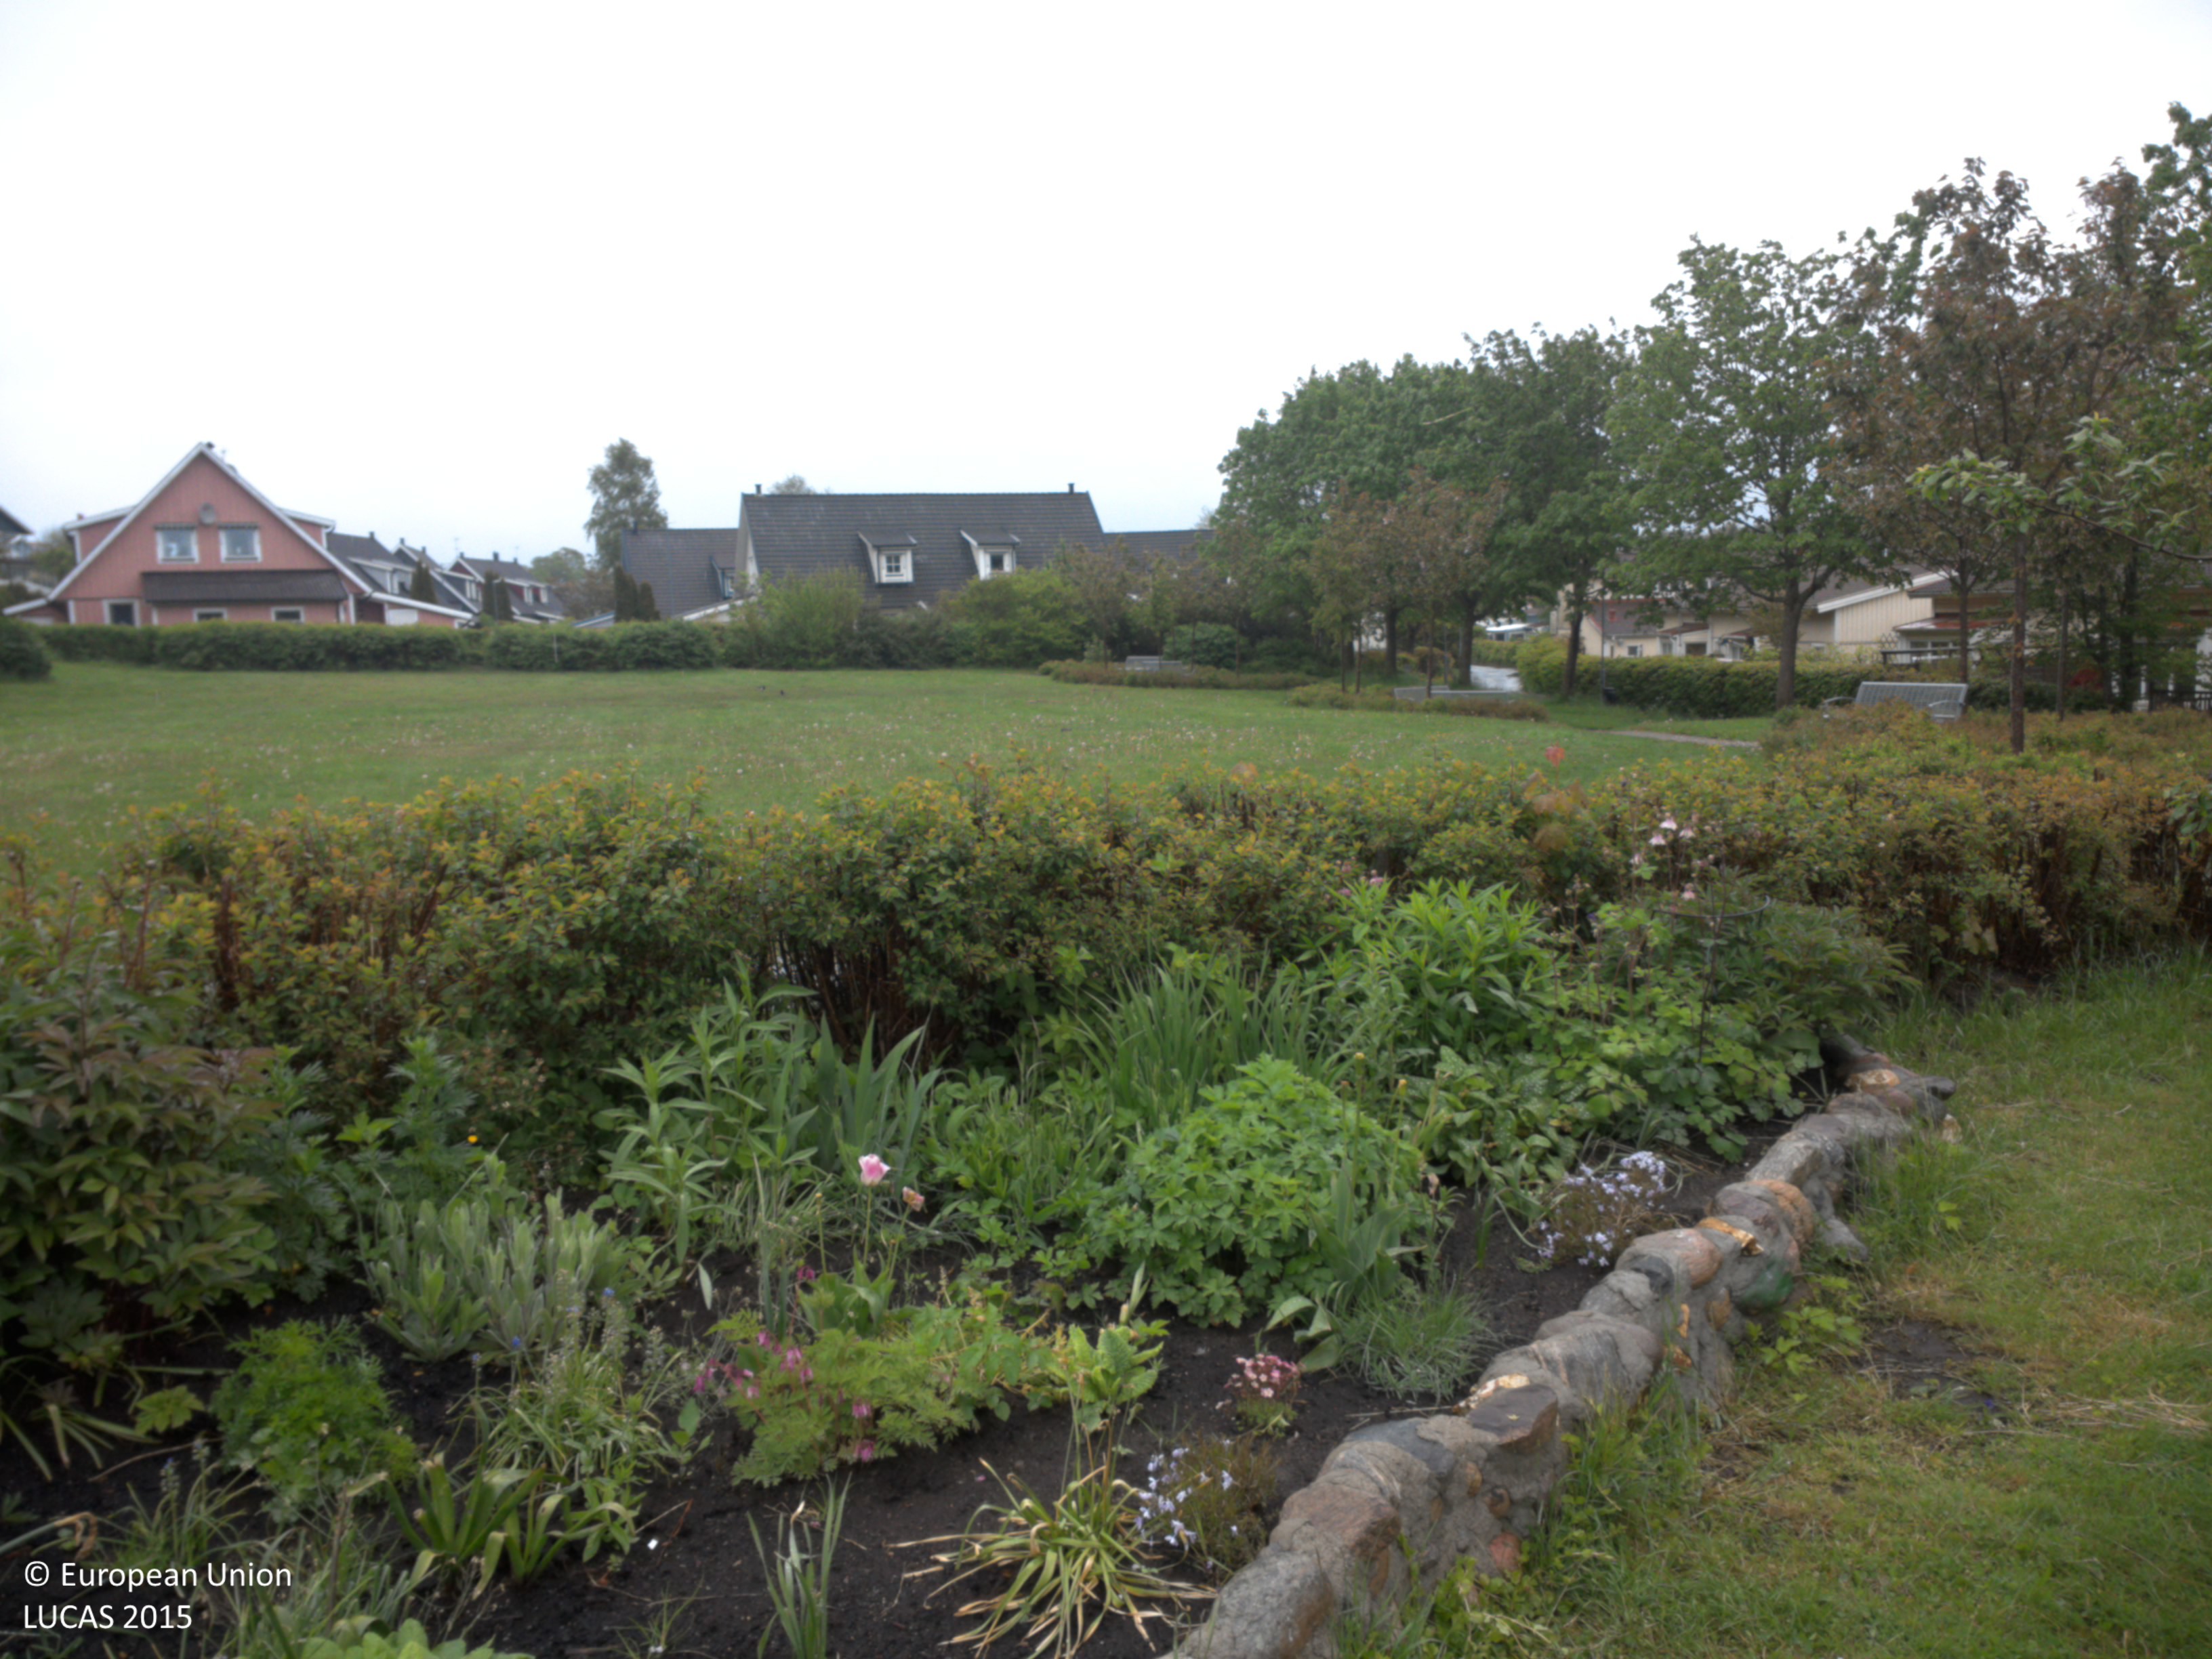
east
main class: Grassland
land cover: Grassland without tree/shrub cover
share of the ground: > 75 %
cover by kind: herbaceous plants 100 %
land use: Residential
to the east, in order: Grassland without tree/shrub cover; Artificial constructions in urban areas; Broadleaved woodland
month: June
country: SE
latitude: 57.8399
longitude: 12.3038
